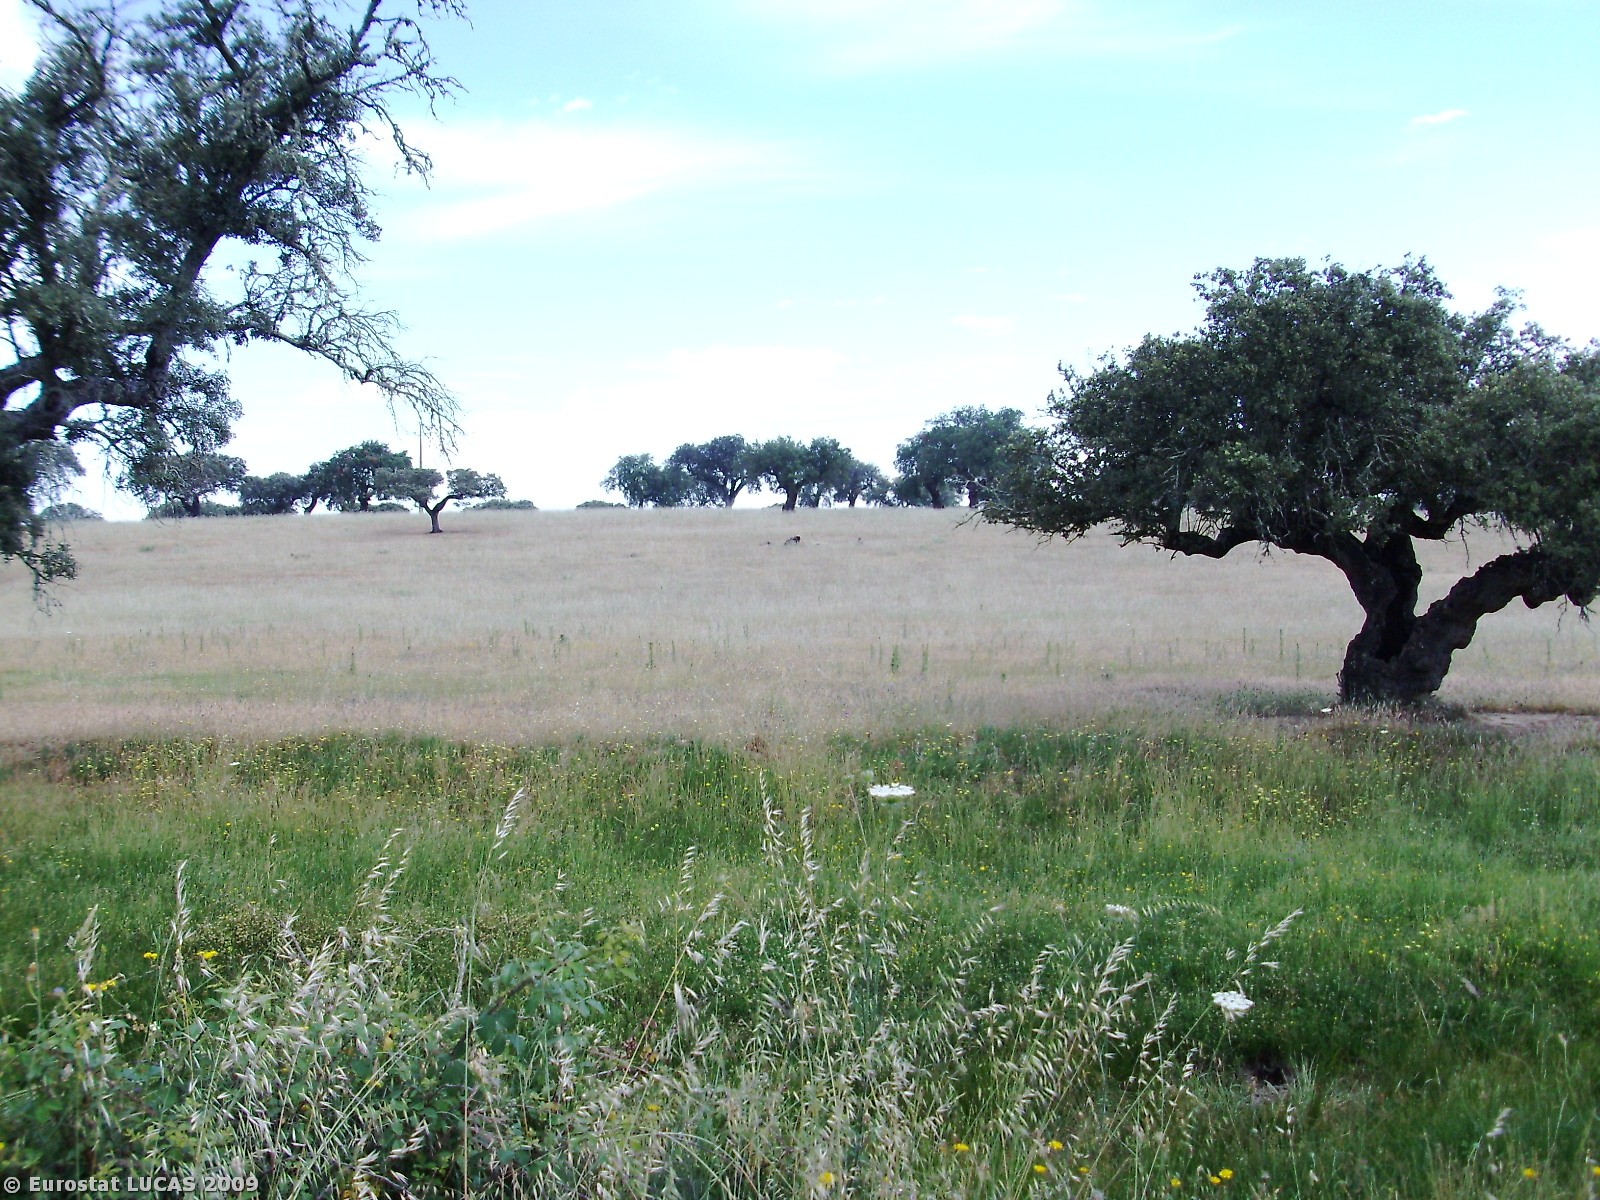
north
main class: Grassland
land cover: Grassland with sparse tree/shrub cover
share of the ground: > 75 %
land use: Agriculture (excluding fallow land and kitchen gardens)
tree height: > 5 m
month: June
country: PT
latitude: 39.1899
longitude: -7.4411
